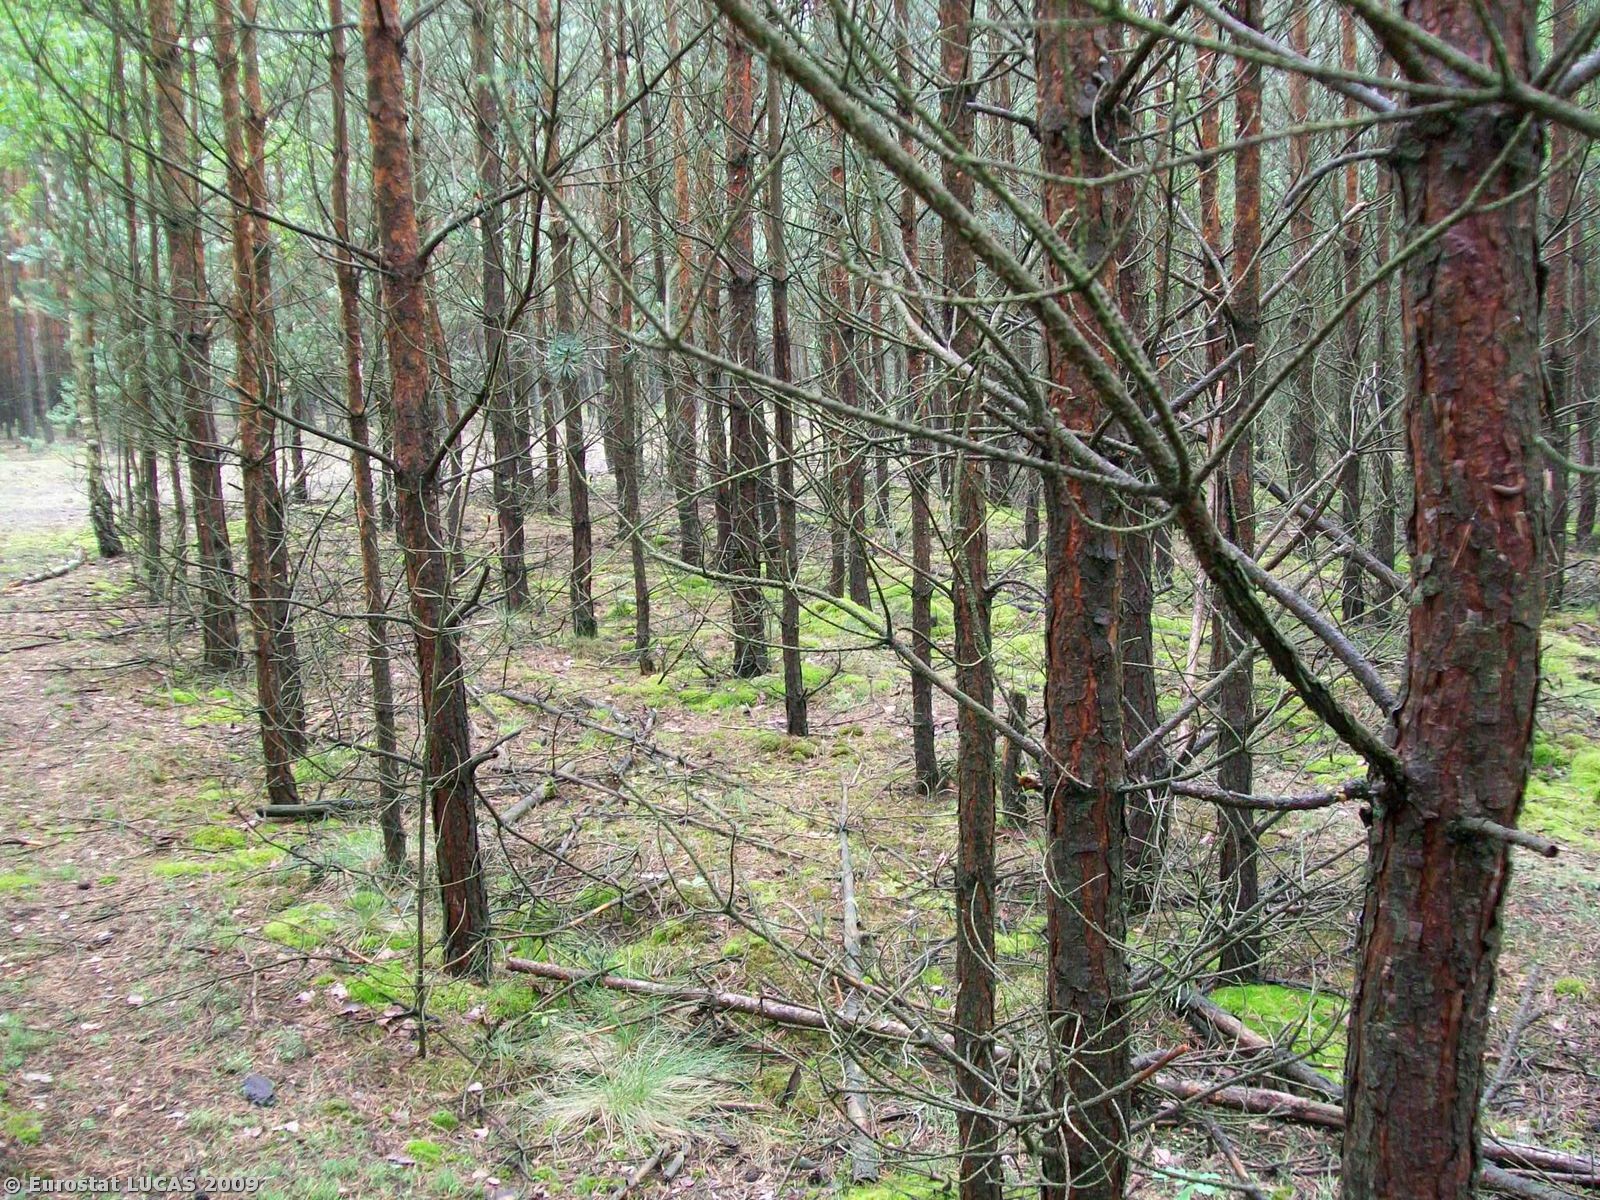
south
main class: Woodland
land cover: Coniferous woodland
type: hemiboreal forest and nemoral coniferous forest and mixed broadleaved-coniferous forest
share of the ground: > 75 %
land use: Forestry
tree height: > 5 m
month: June
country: PL
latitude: 51.3826
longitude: 15.1616
